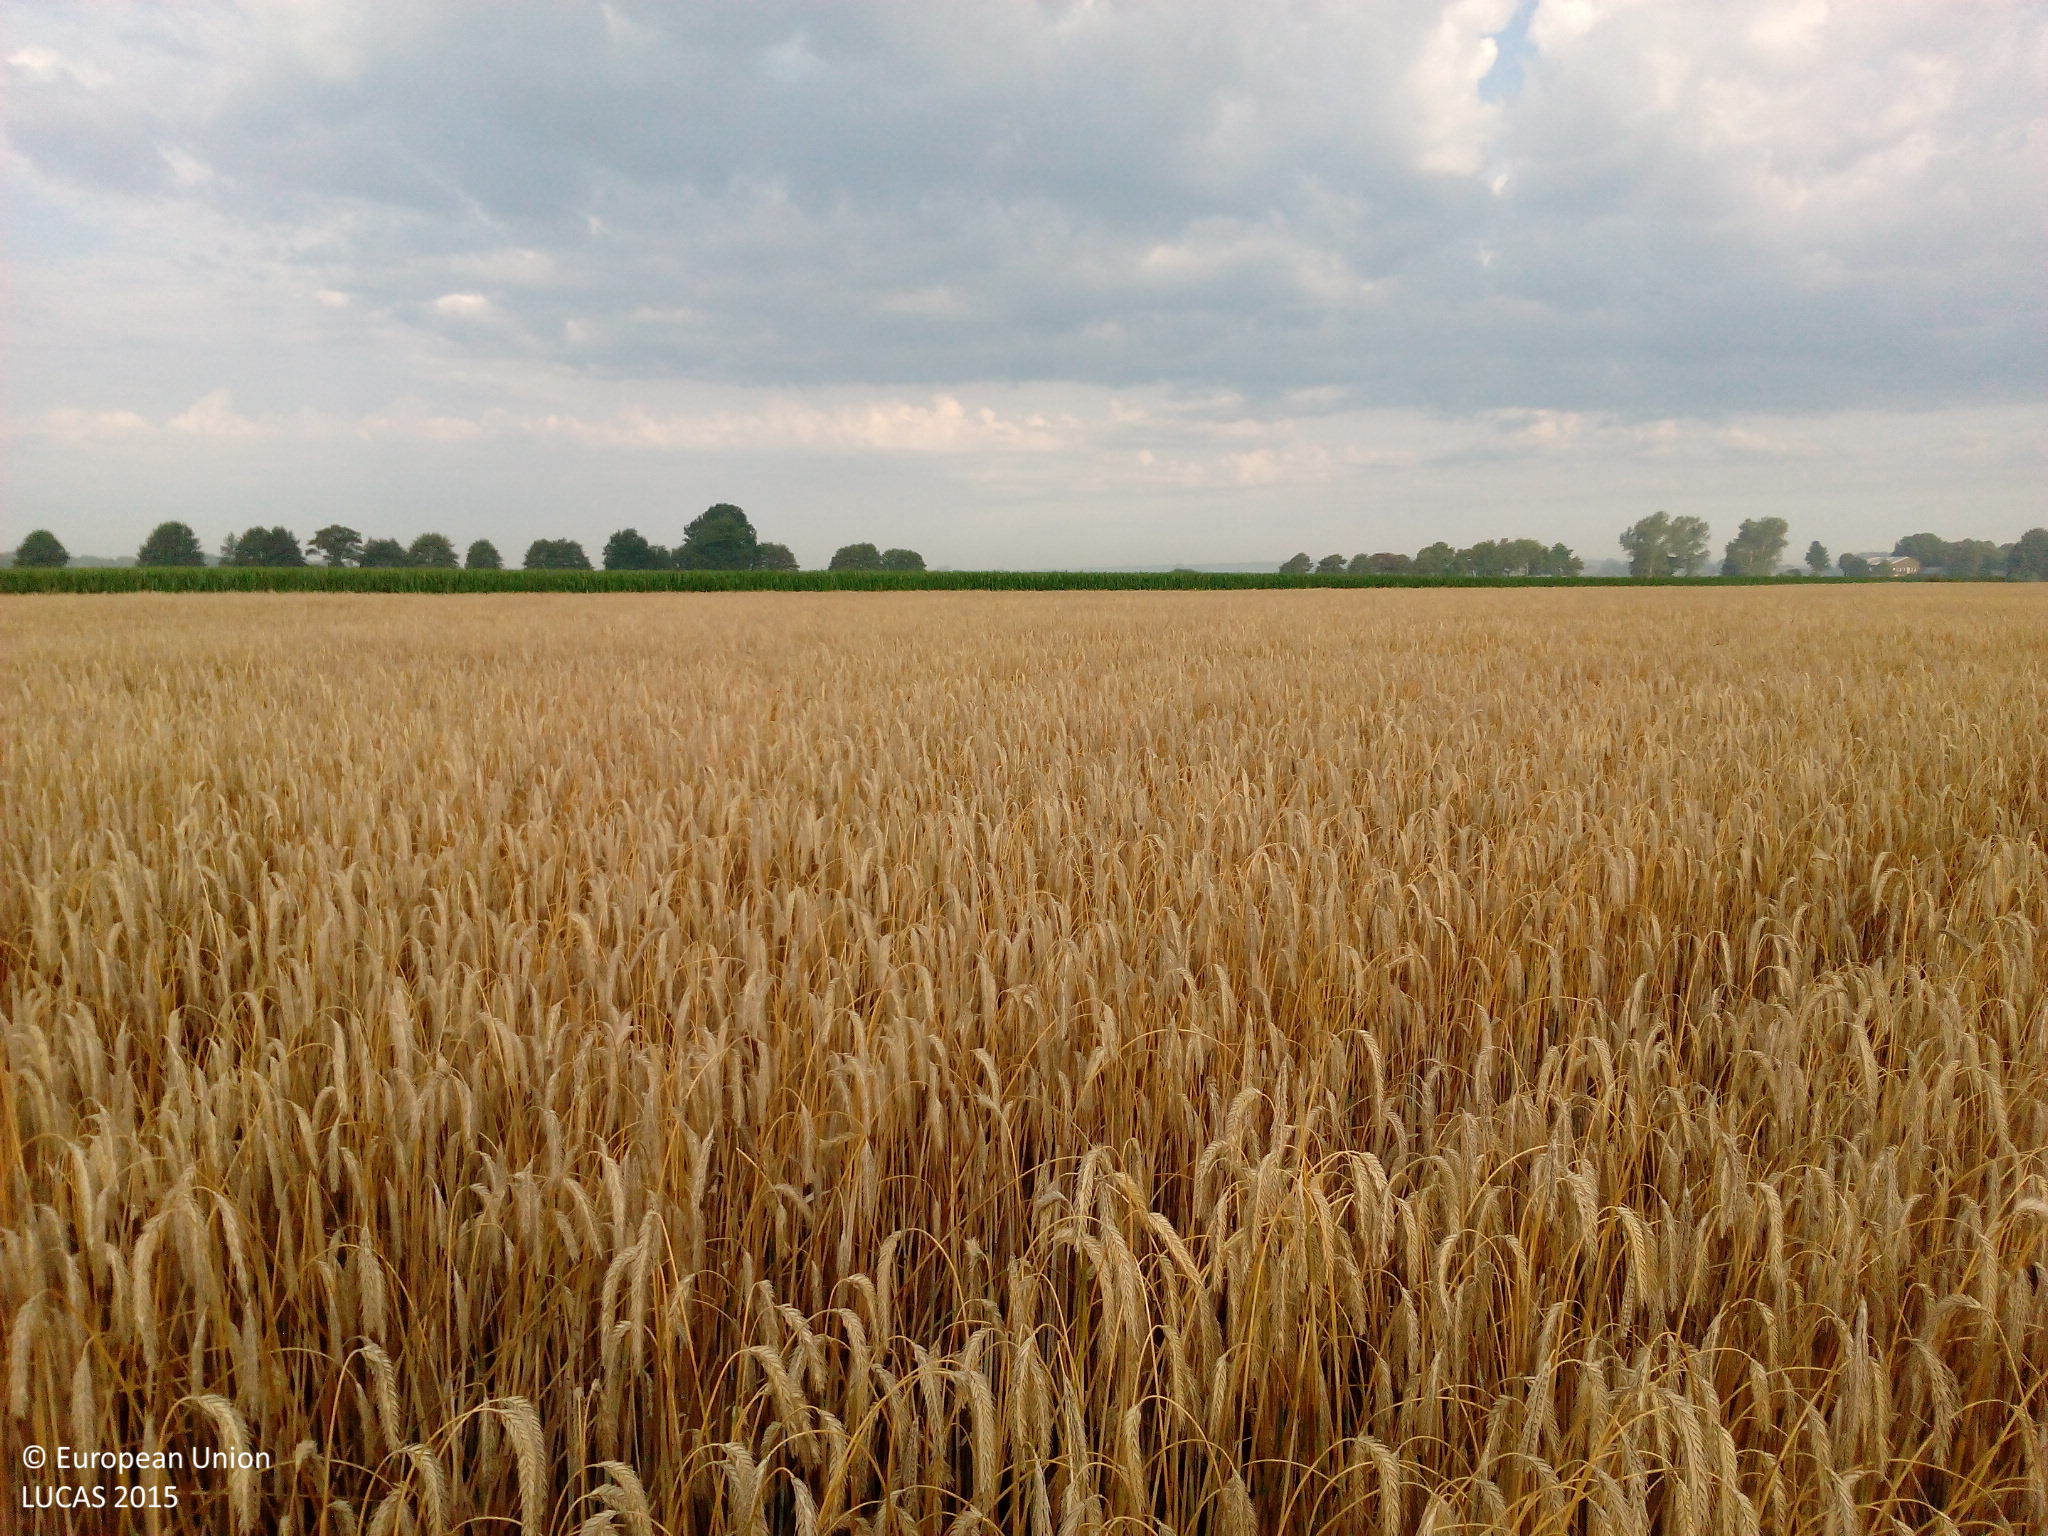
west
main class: Cropland
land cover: Rye
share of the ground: > 75 %
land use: Agriculture (excluding fallow land and kitchen gardens)
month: August
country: DE
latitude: 53.9046
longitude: 9.6501
